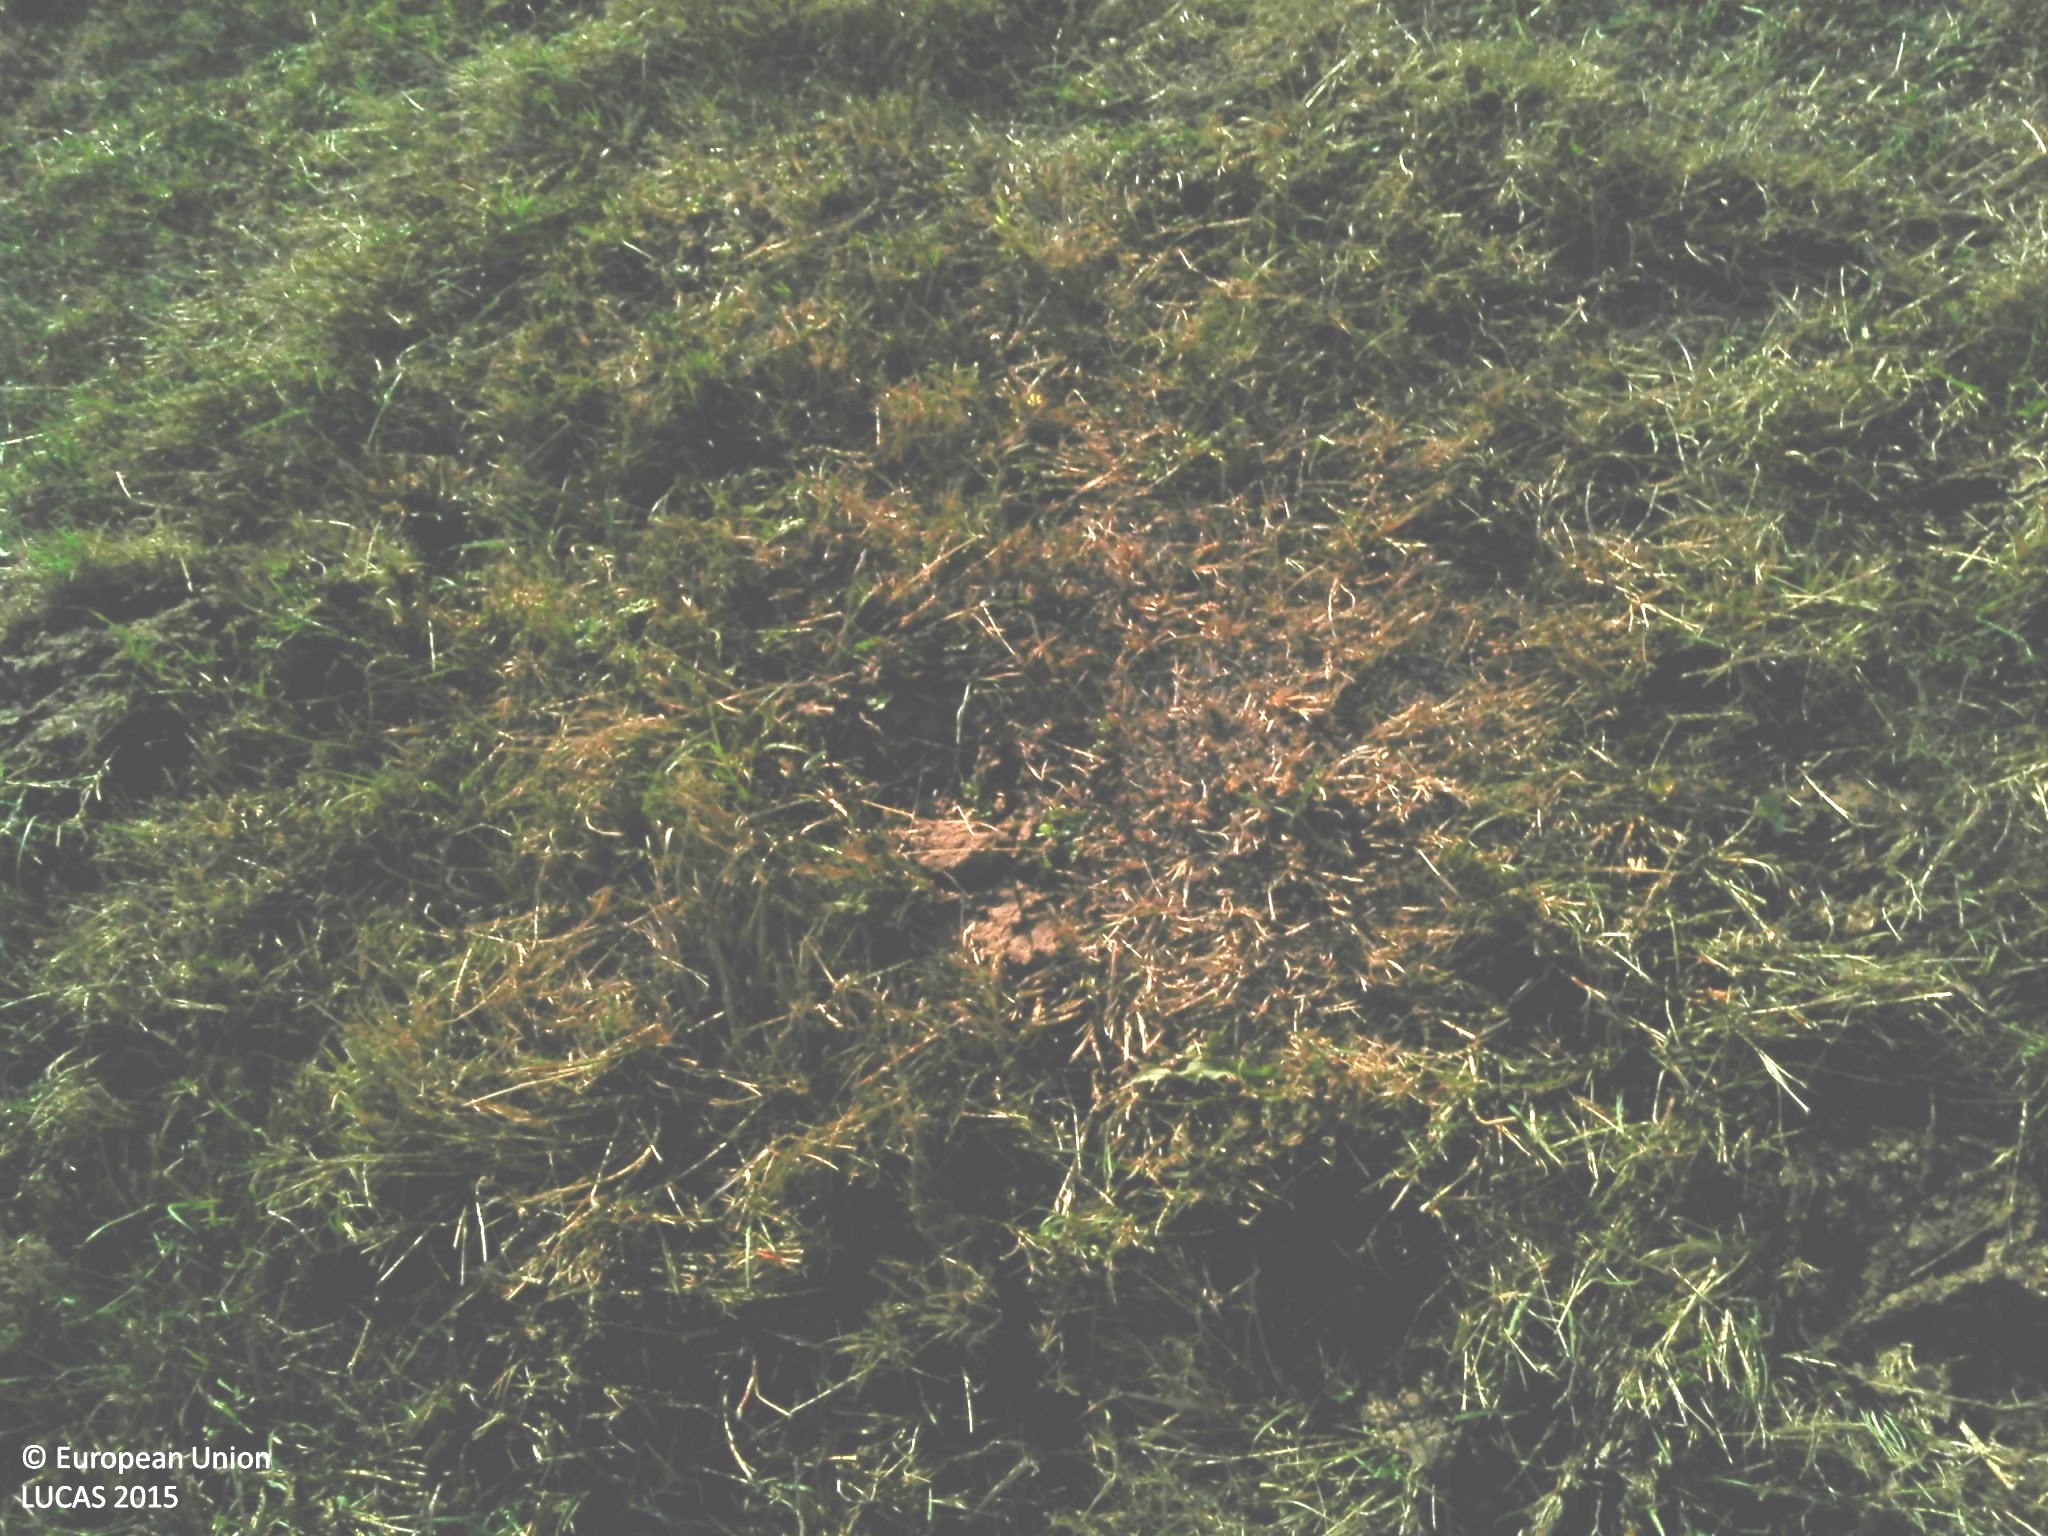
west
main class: Grassland
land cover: Grassland without tree/shrub cover
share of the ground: > 75 %
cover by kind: herbaceous plants 100 %
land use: Agriculture (excluding fallow land and kitchen gardens)
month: July
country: FR
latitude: 46.7749
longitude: 3.6206
